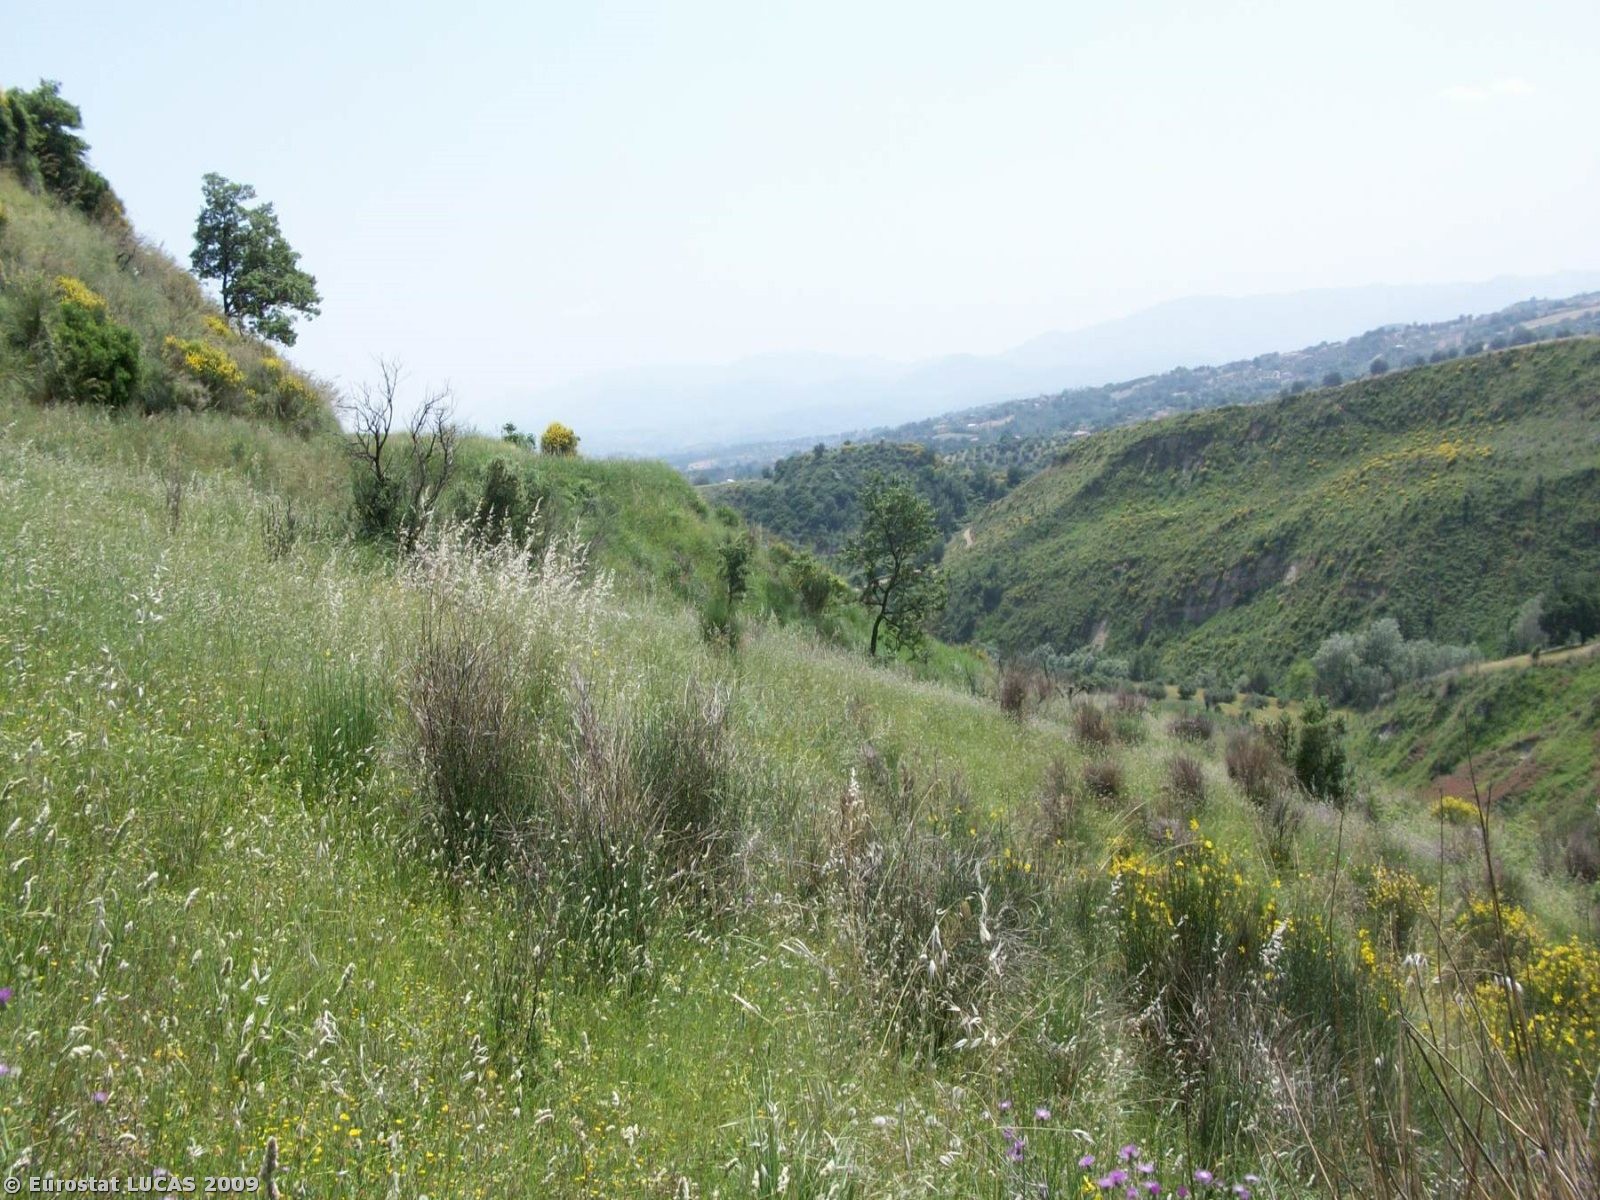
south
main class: Shrubland
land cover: Shrubland with sparse tree cover
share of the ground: > 75 %
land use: Fallow land
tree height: < 5 m
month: May
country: IT
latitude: 39.7103
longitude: 16.1656
